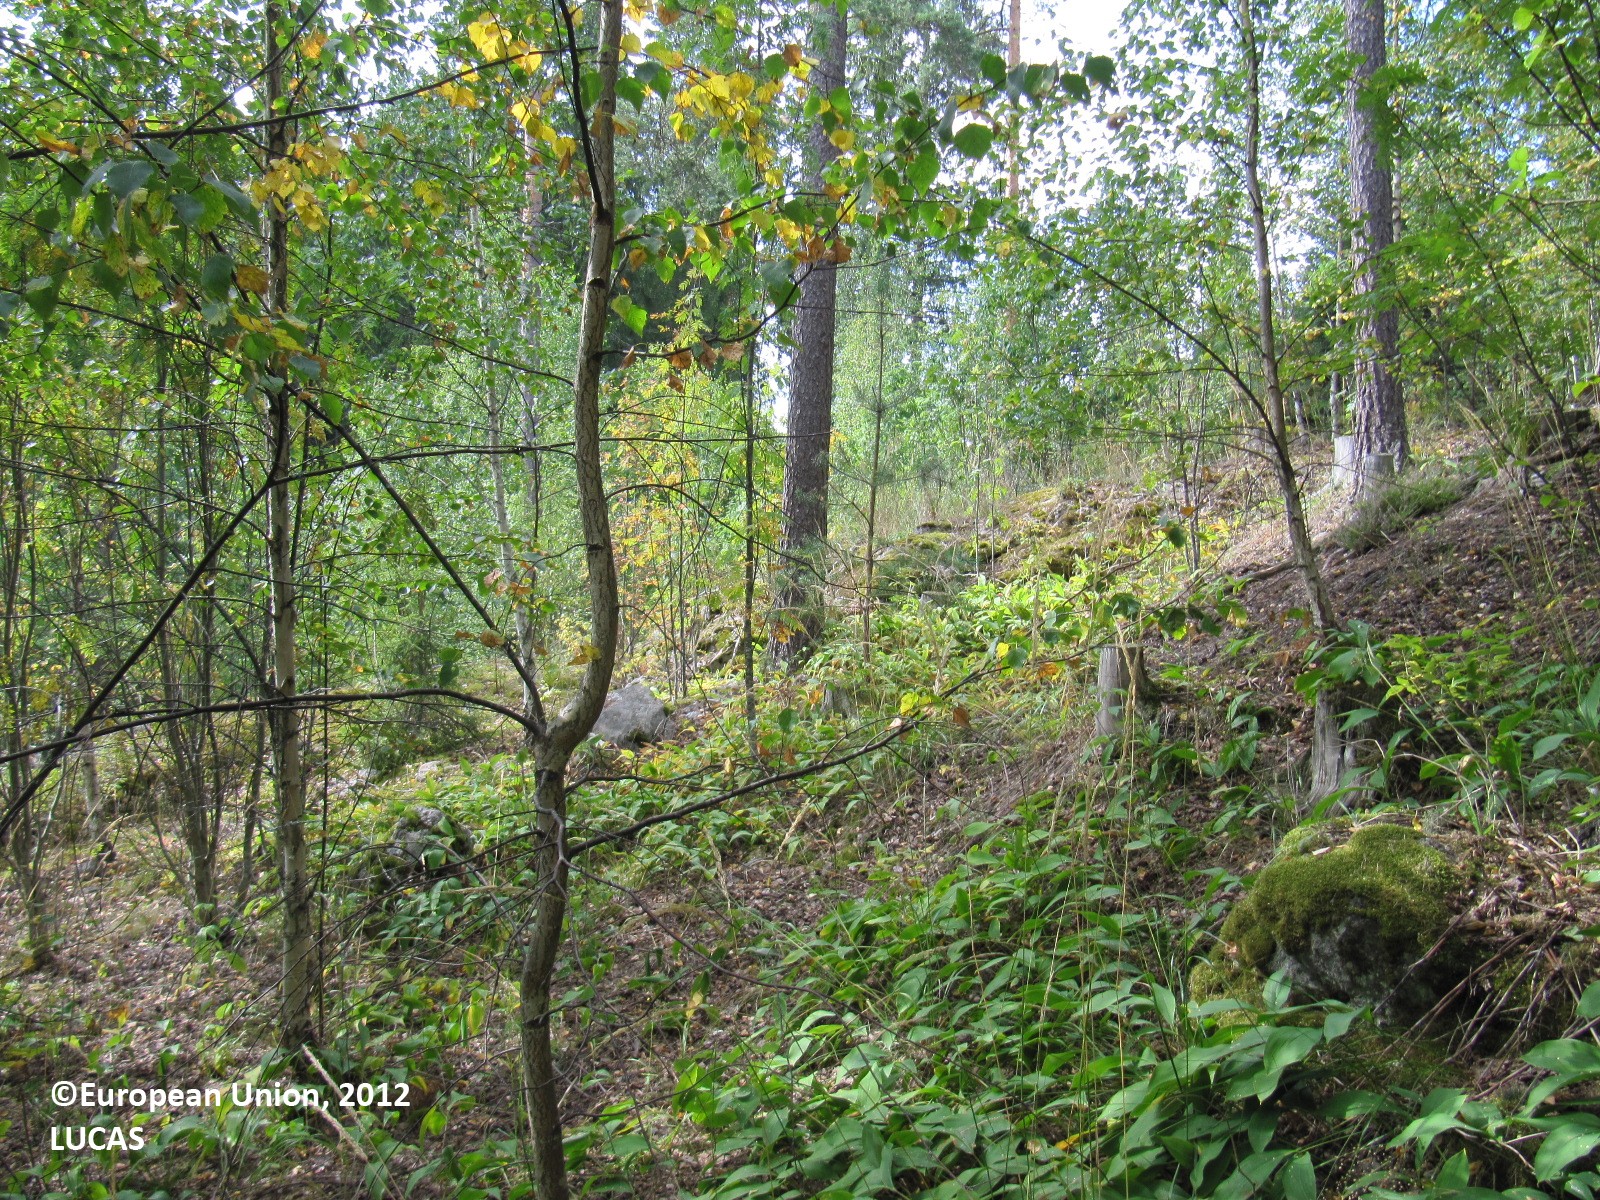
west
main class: Woodland
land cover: Broadleaved woodland
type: boreal forest
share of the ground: > 75 %
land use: Forestry
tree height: > 5 m
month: August
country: FI
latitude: 60.4306
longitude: 24.3649
